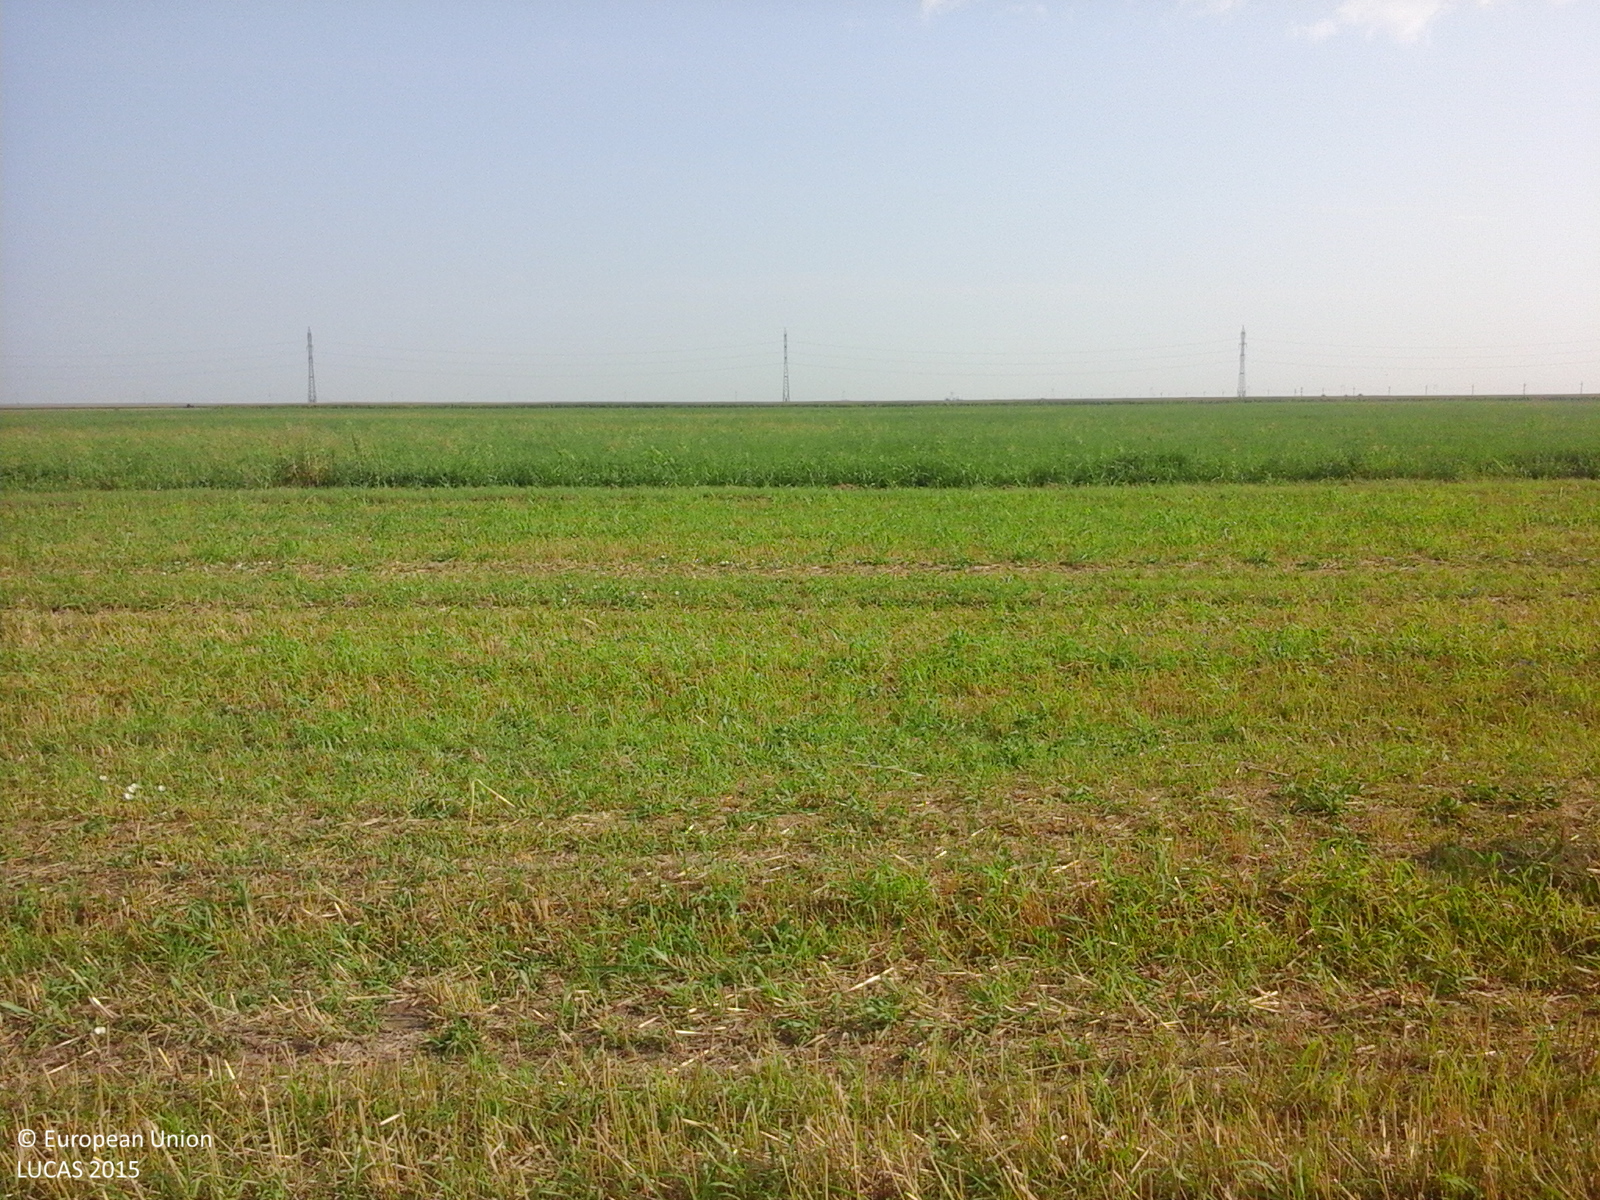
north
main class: Cropland
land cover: Barley
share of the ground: < 10 %
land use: Agriculture (excluding fallow land and kitchen gardens)
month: July
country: RO
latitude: 44.6180
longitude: 27.4977
